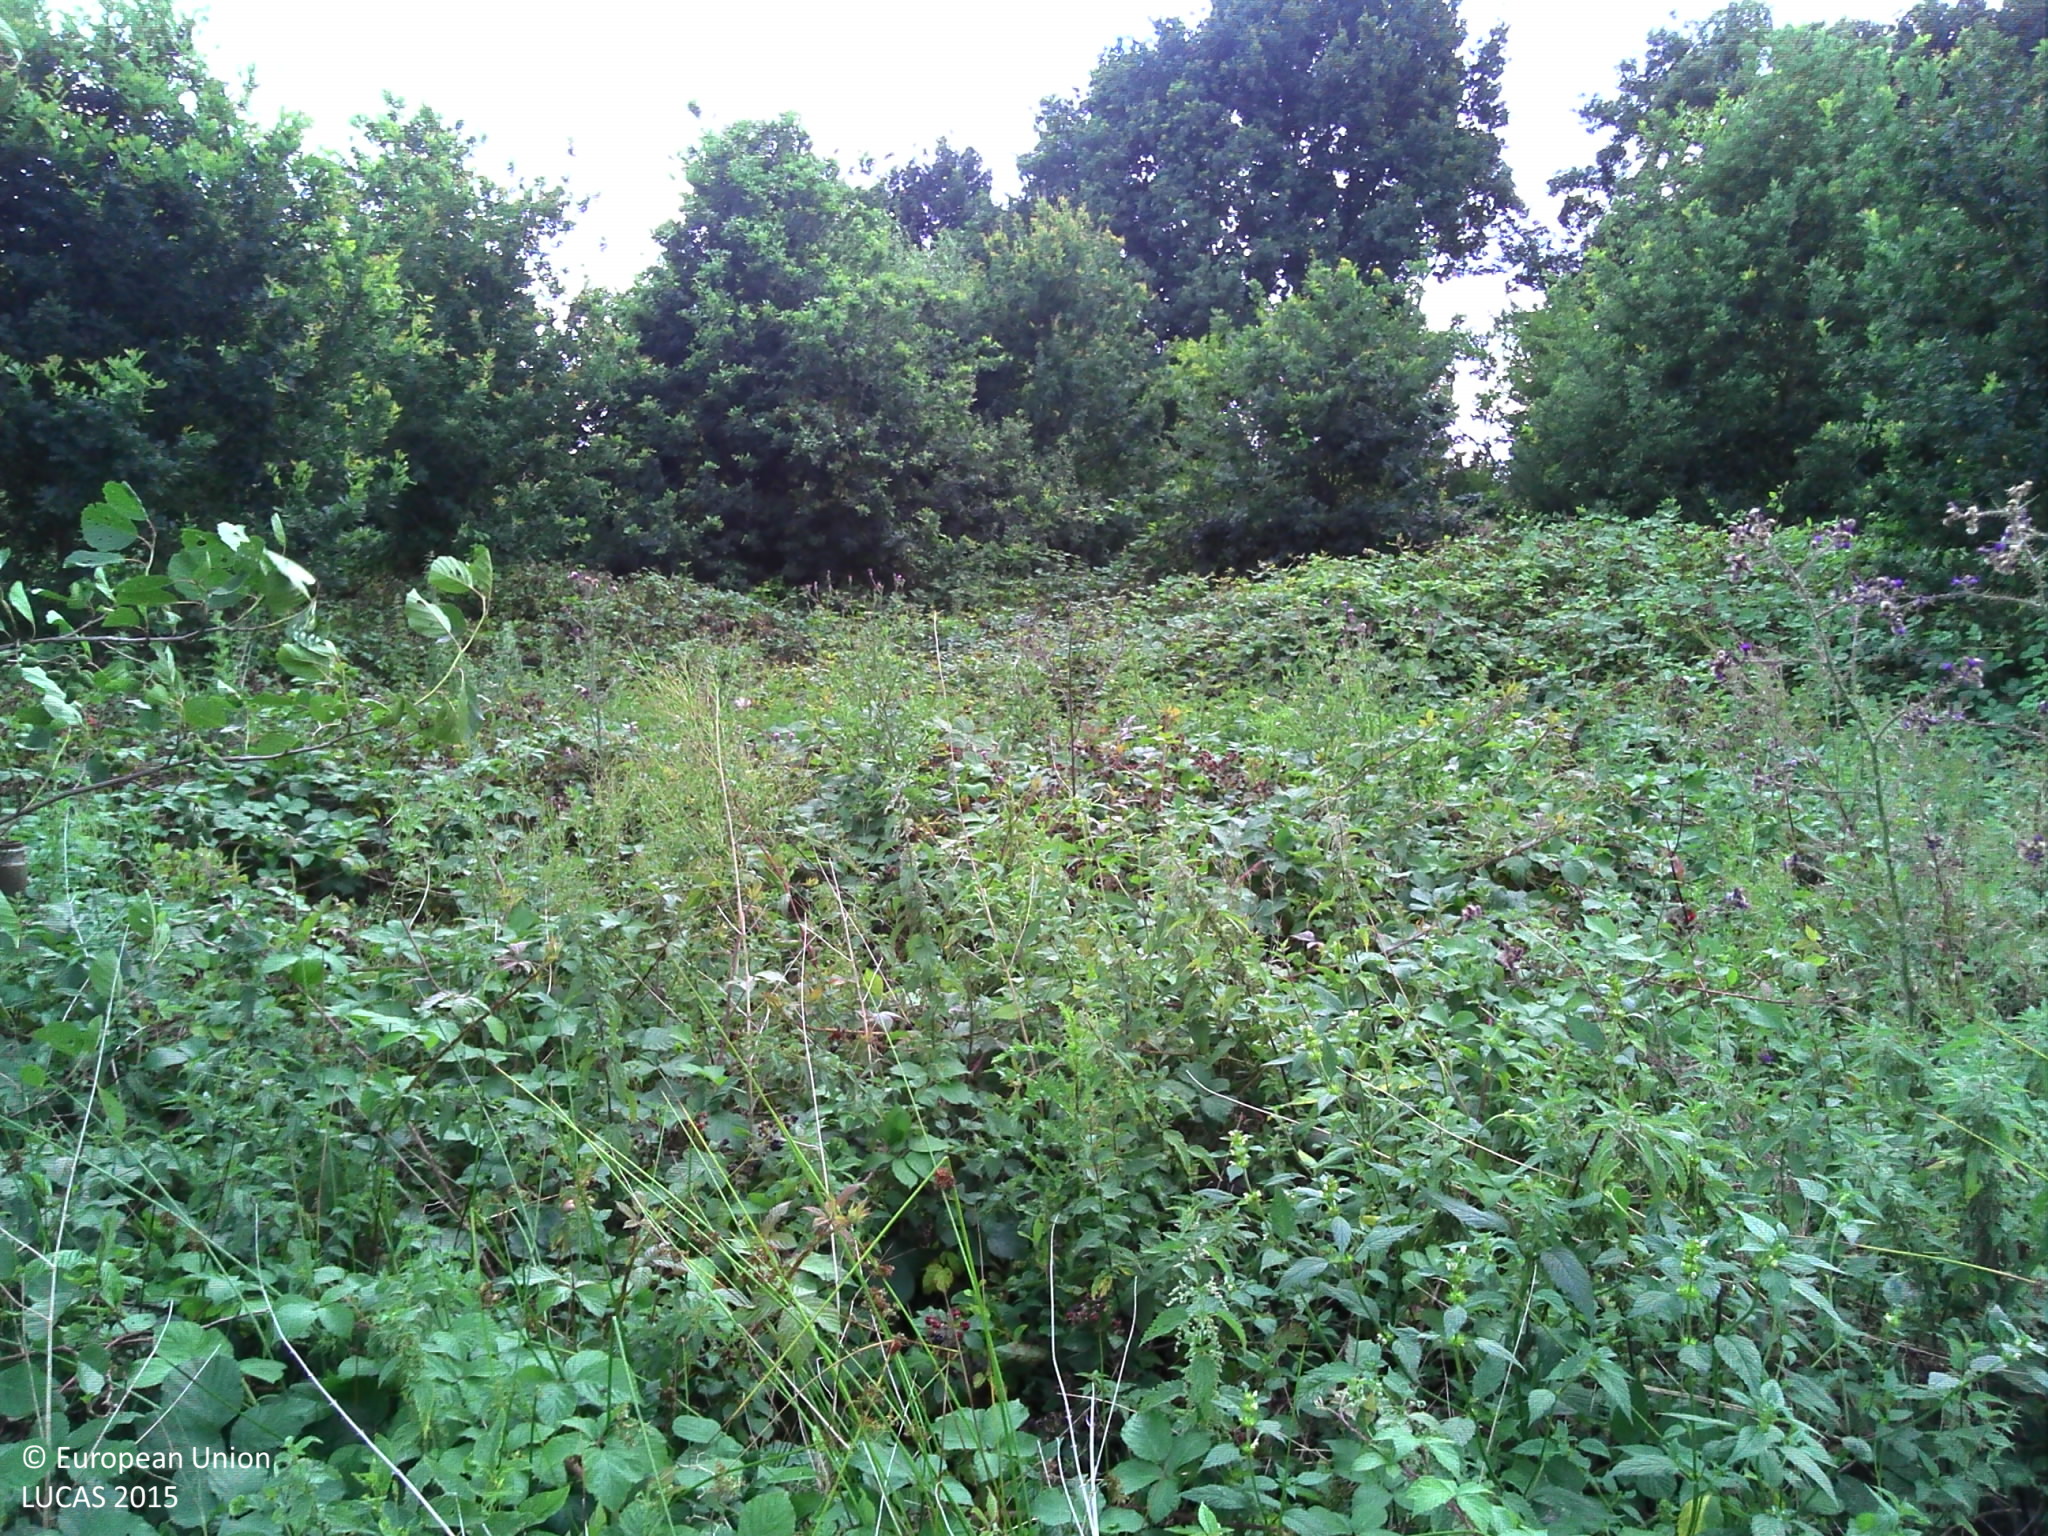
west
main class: Woodland
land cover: Broadleaved woodland
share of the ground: > 75 %
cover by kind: broadleaved forest trees 80 %, coniferous forest trees 10 %, shrubs 10 %
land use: Semi-natural and natural areas not in use
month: July
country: BE
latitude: 51.0622
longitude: 4.5309
